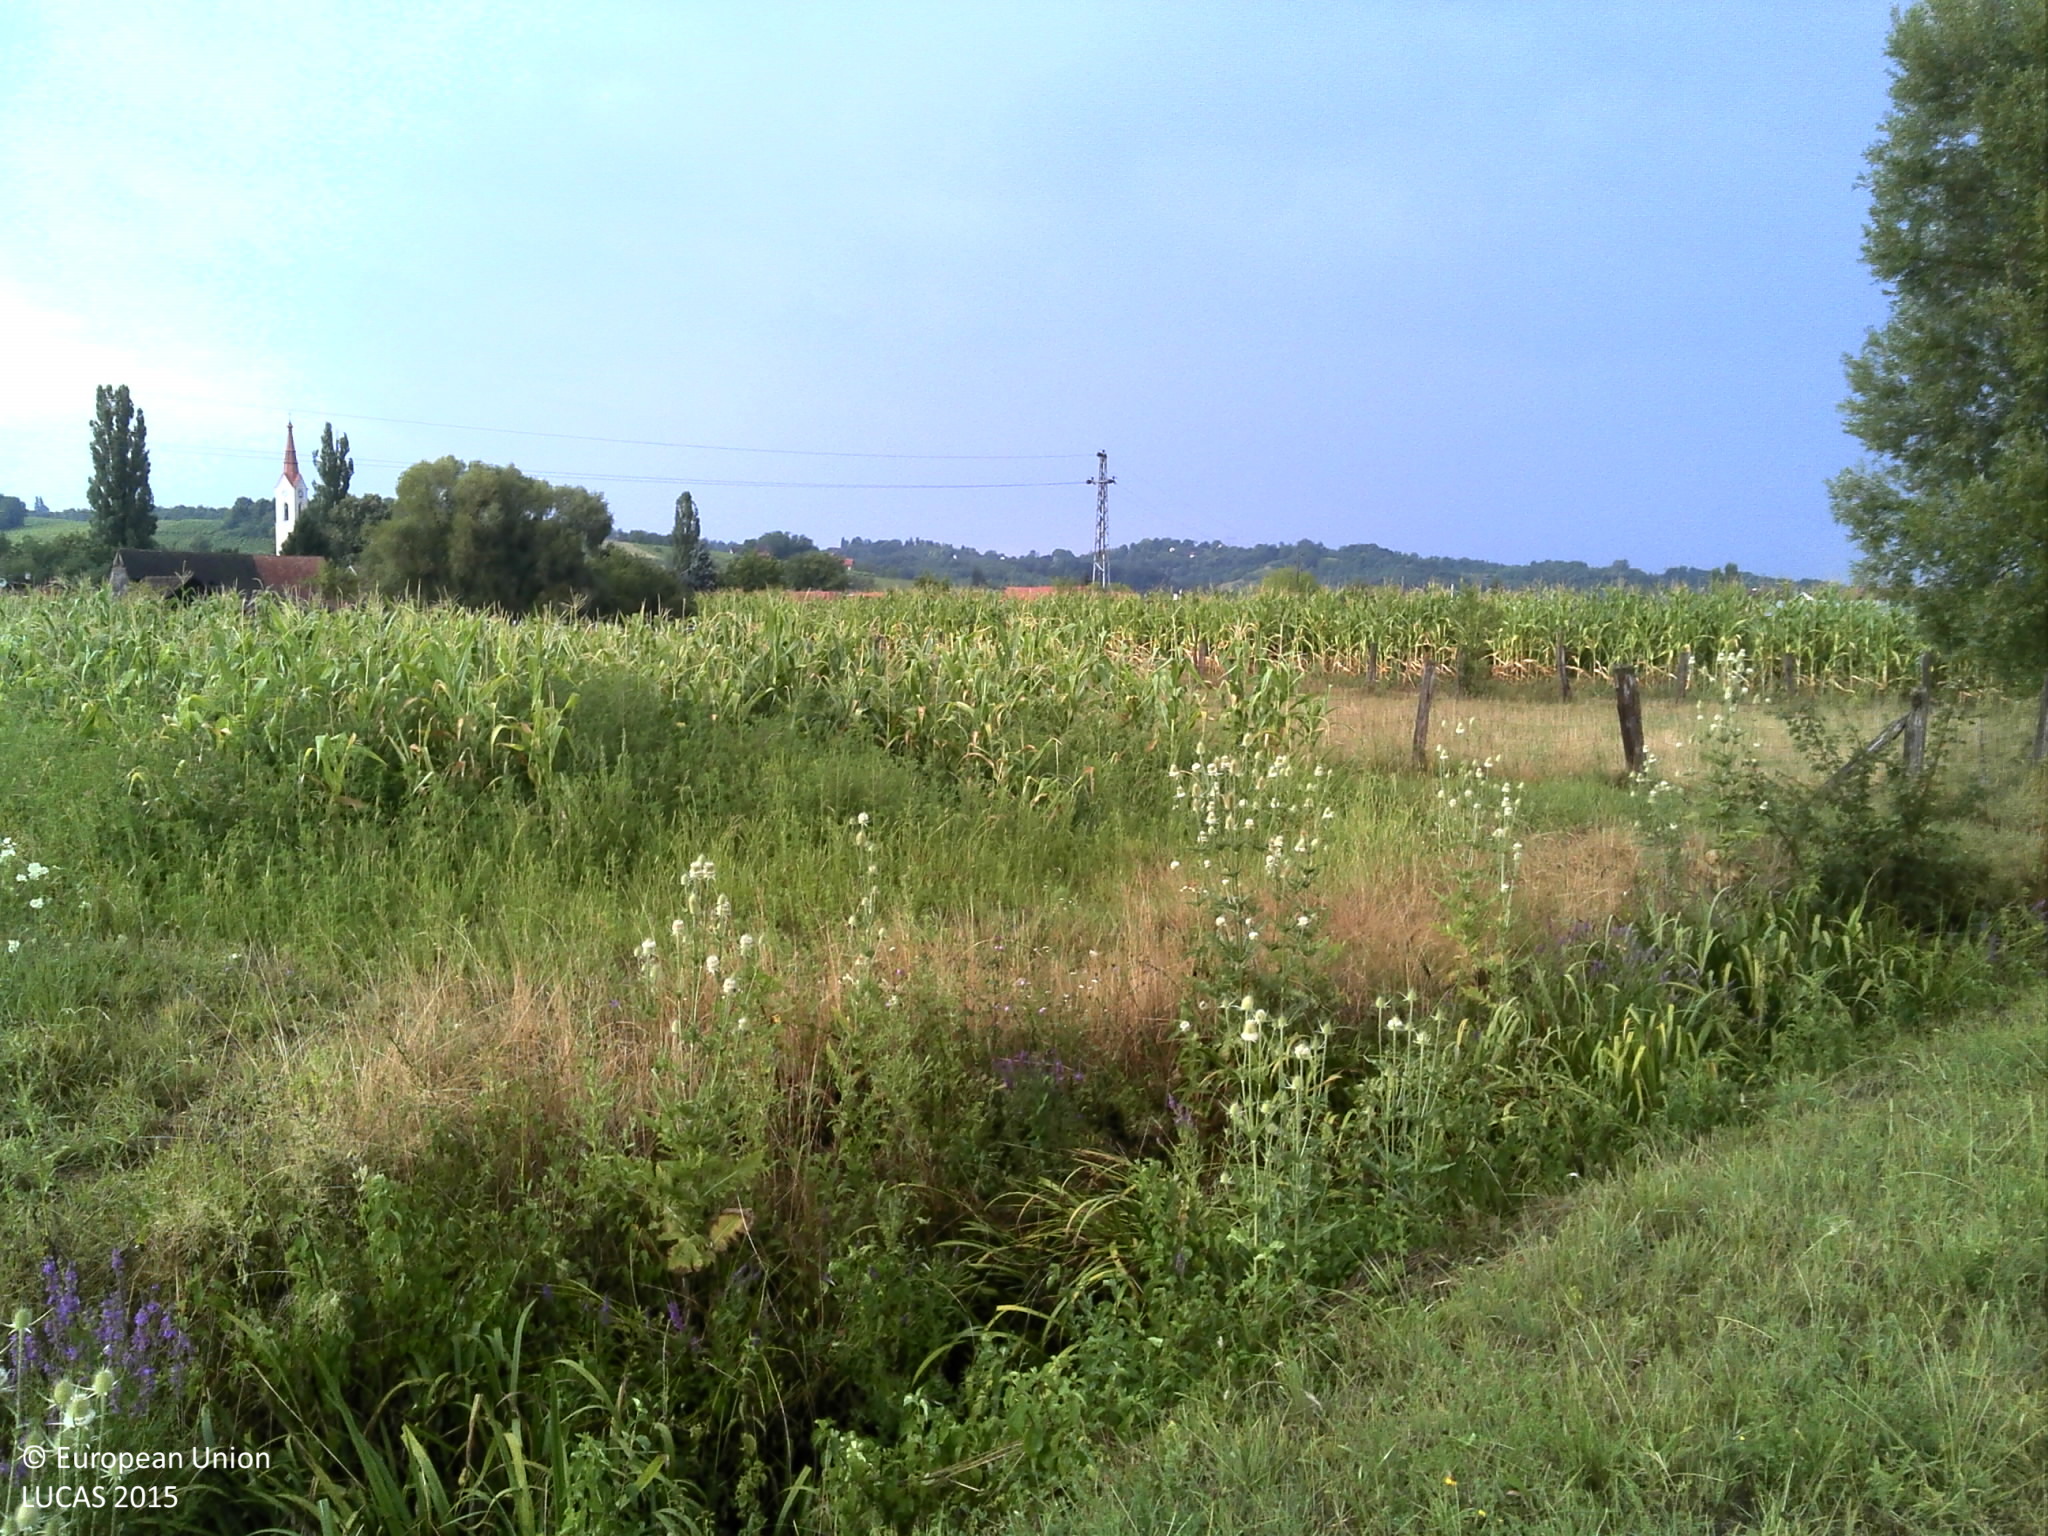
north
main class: Artificial land
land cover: Non built-up linear features
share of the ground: > 75 %
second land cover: Grassland without tree/shrub cover
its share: > 75 %
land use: Road transport
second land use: Agriculture (excluding fallow land and kitchen gardens)
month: July
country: HR
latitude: 45.5464
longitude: 16.6719
